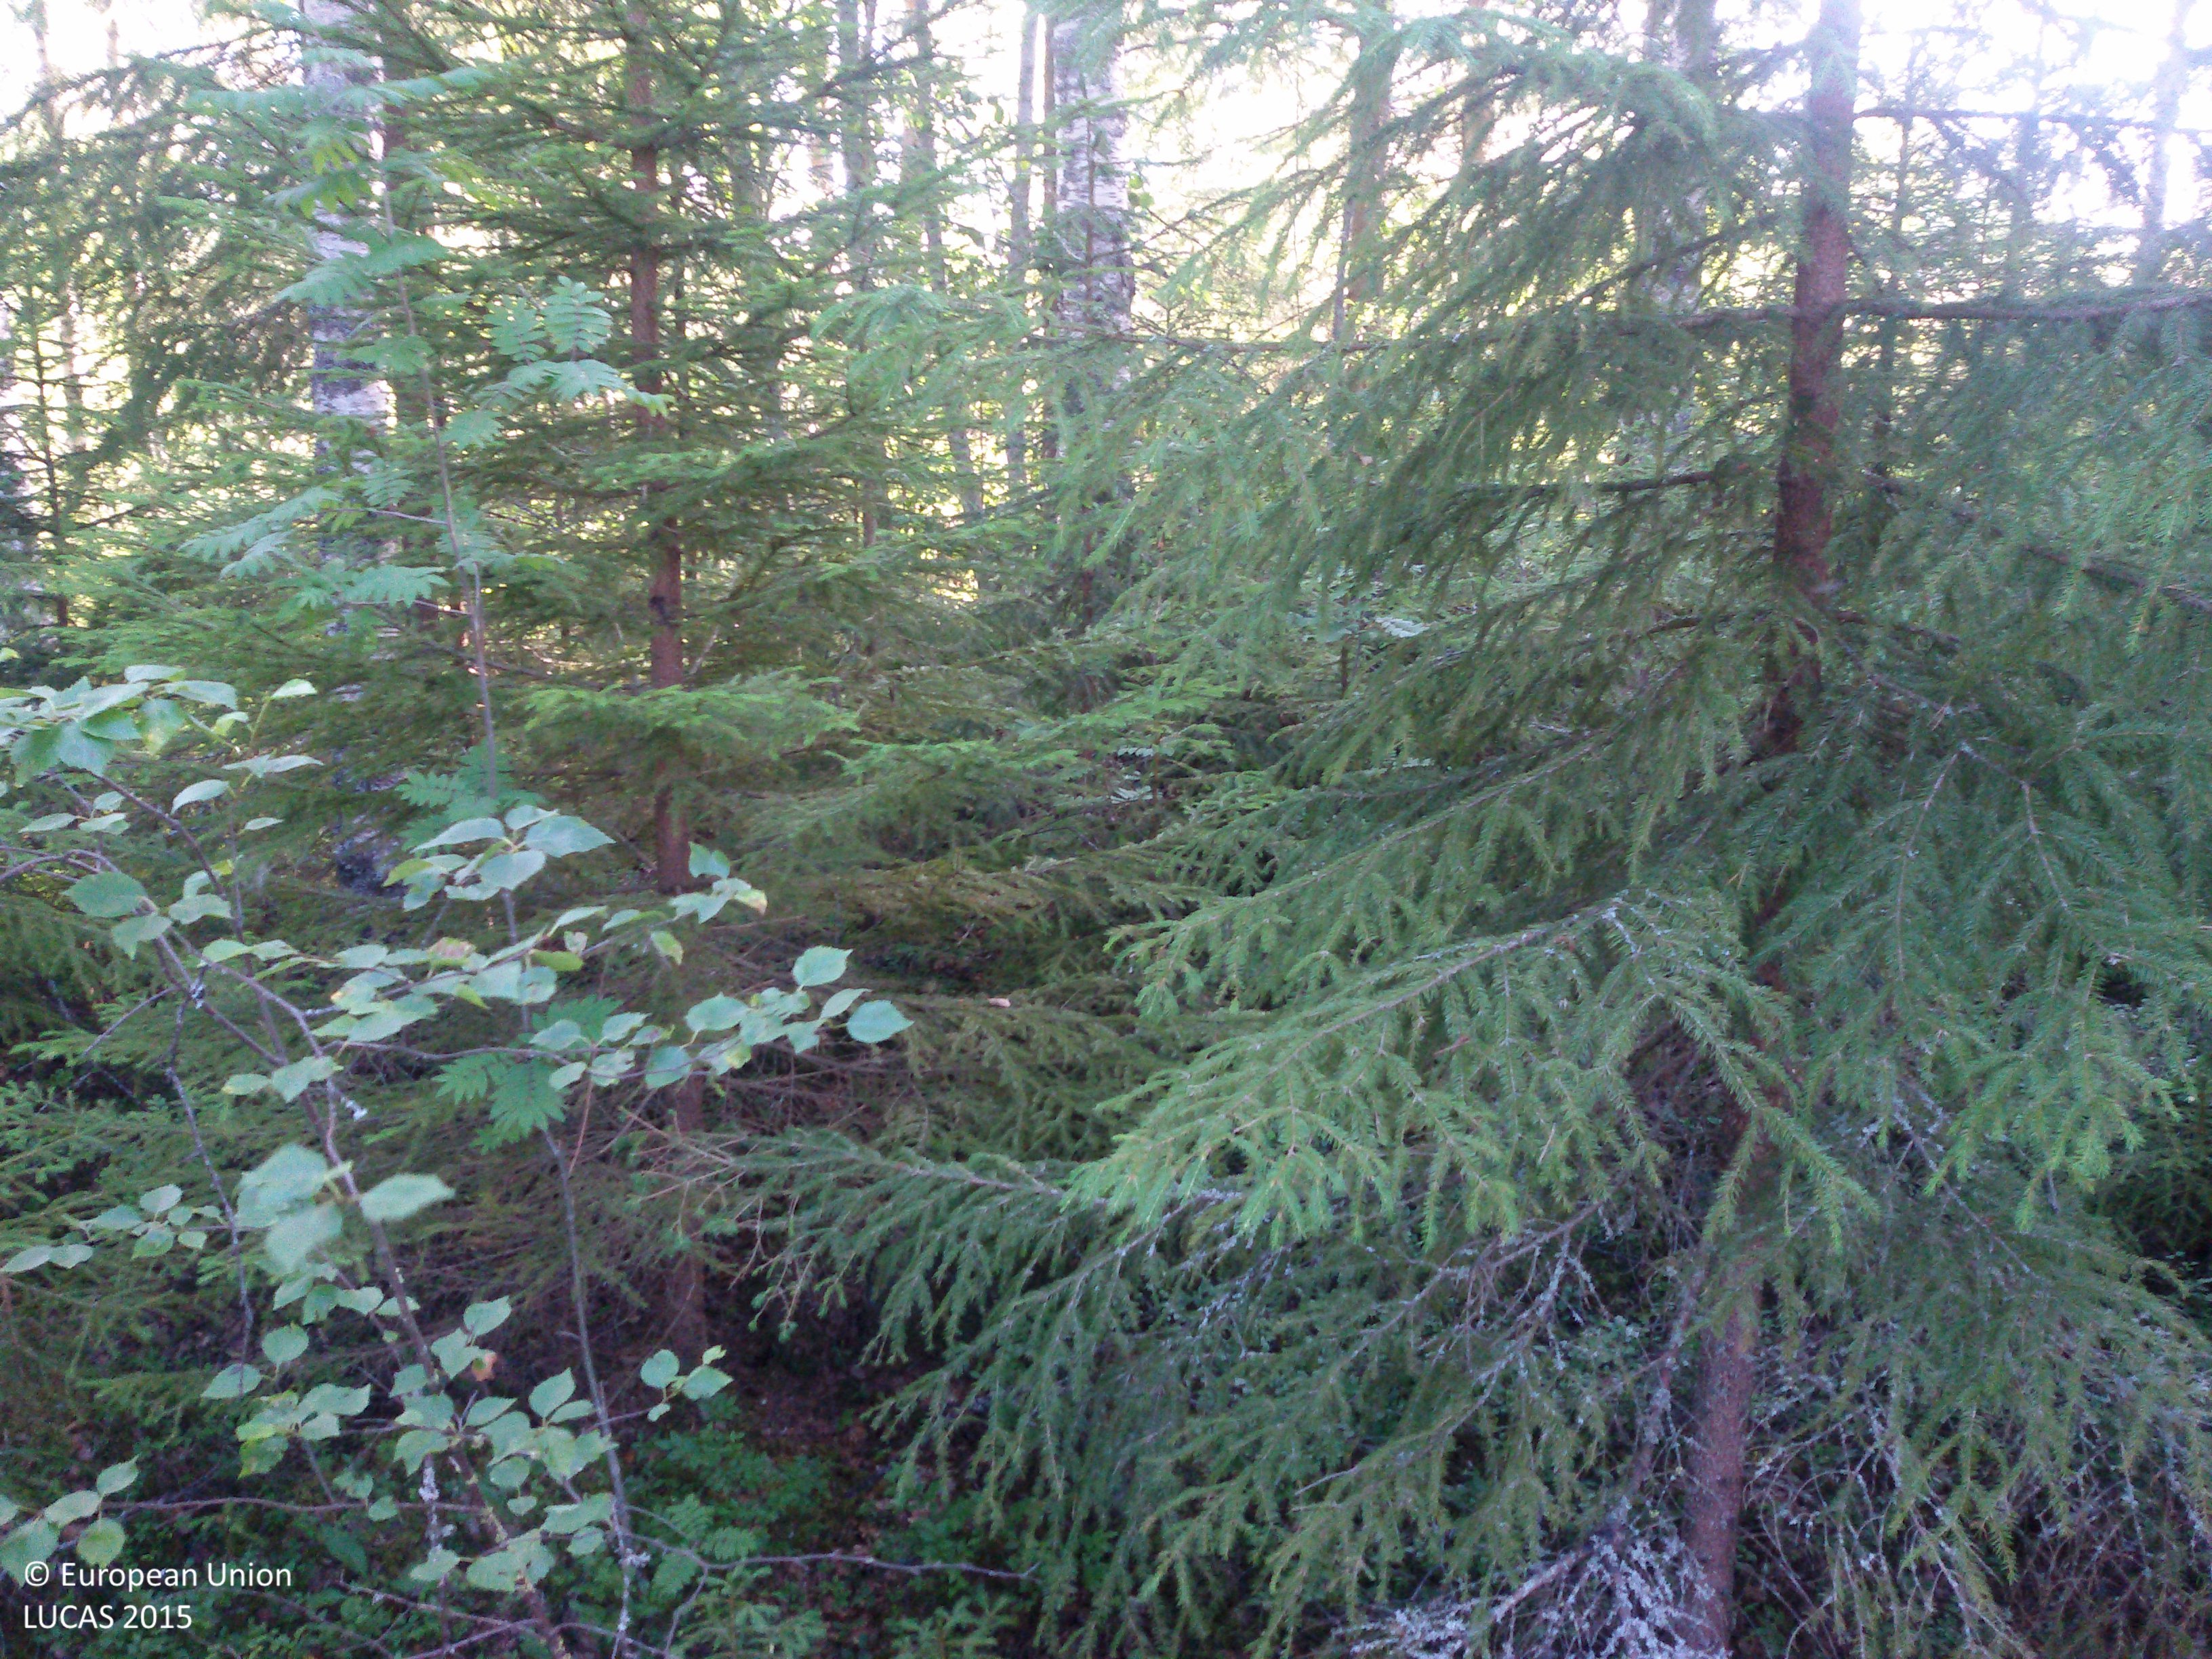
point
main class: Woodland
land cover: Spruce dominated mixed woodland
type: boreal forest
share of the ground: > 75 %
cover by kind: coniferous forest trees 40 %, broadleaved forest trees 40 %, herbaceous plants 10 %, lichens and mosses 10 %
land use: Forestry
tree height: > 5 m
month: July
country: SE
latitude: 60.6735
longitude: 15.3866
